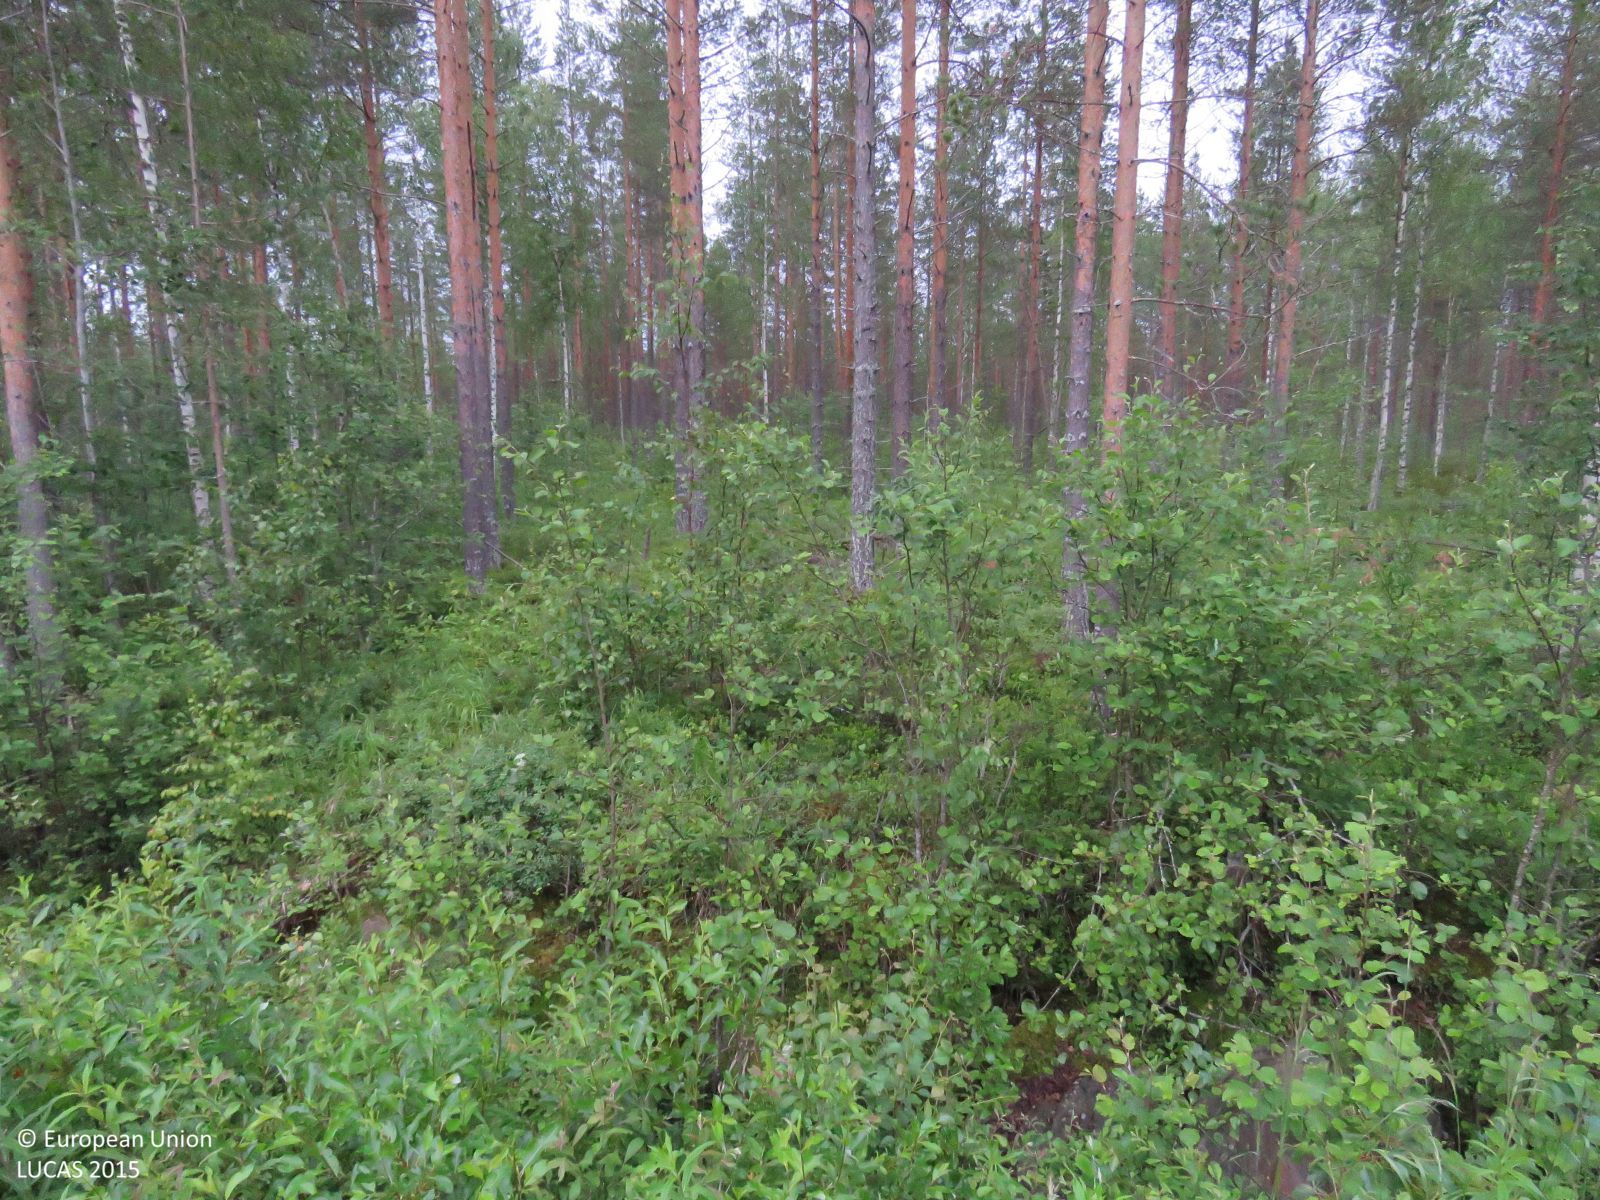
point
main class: Woodland
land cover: Pine dominated mixed woodland
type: boreal forest
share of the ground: > 75 %
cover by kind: coniferous forest trees 55 %, broadleaved forest trees 20 %, shrubs 20 %, lichens and mosses 5 %
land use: Forestry
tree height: > 5 m
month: July
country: FI
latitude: 64.3163
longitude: 26.5589
